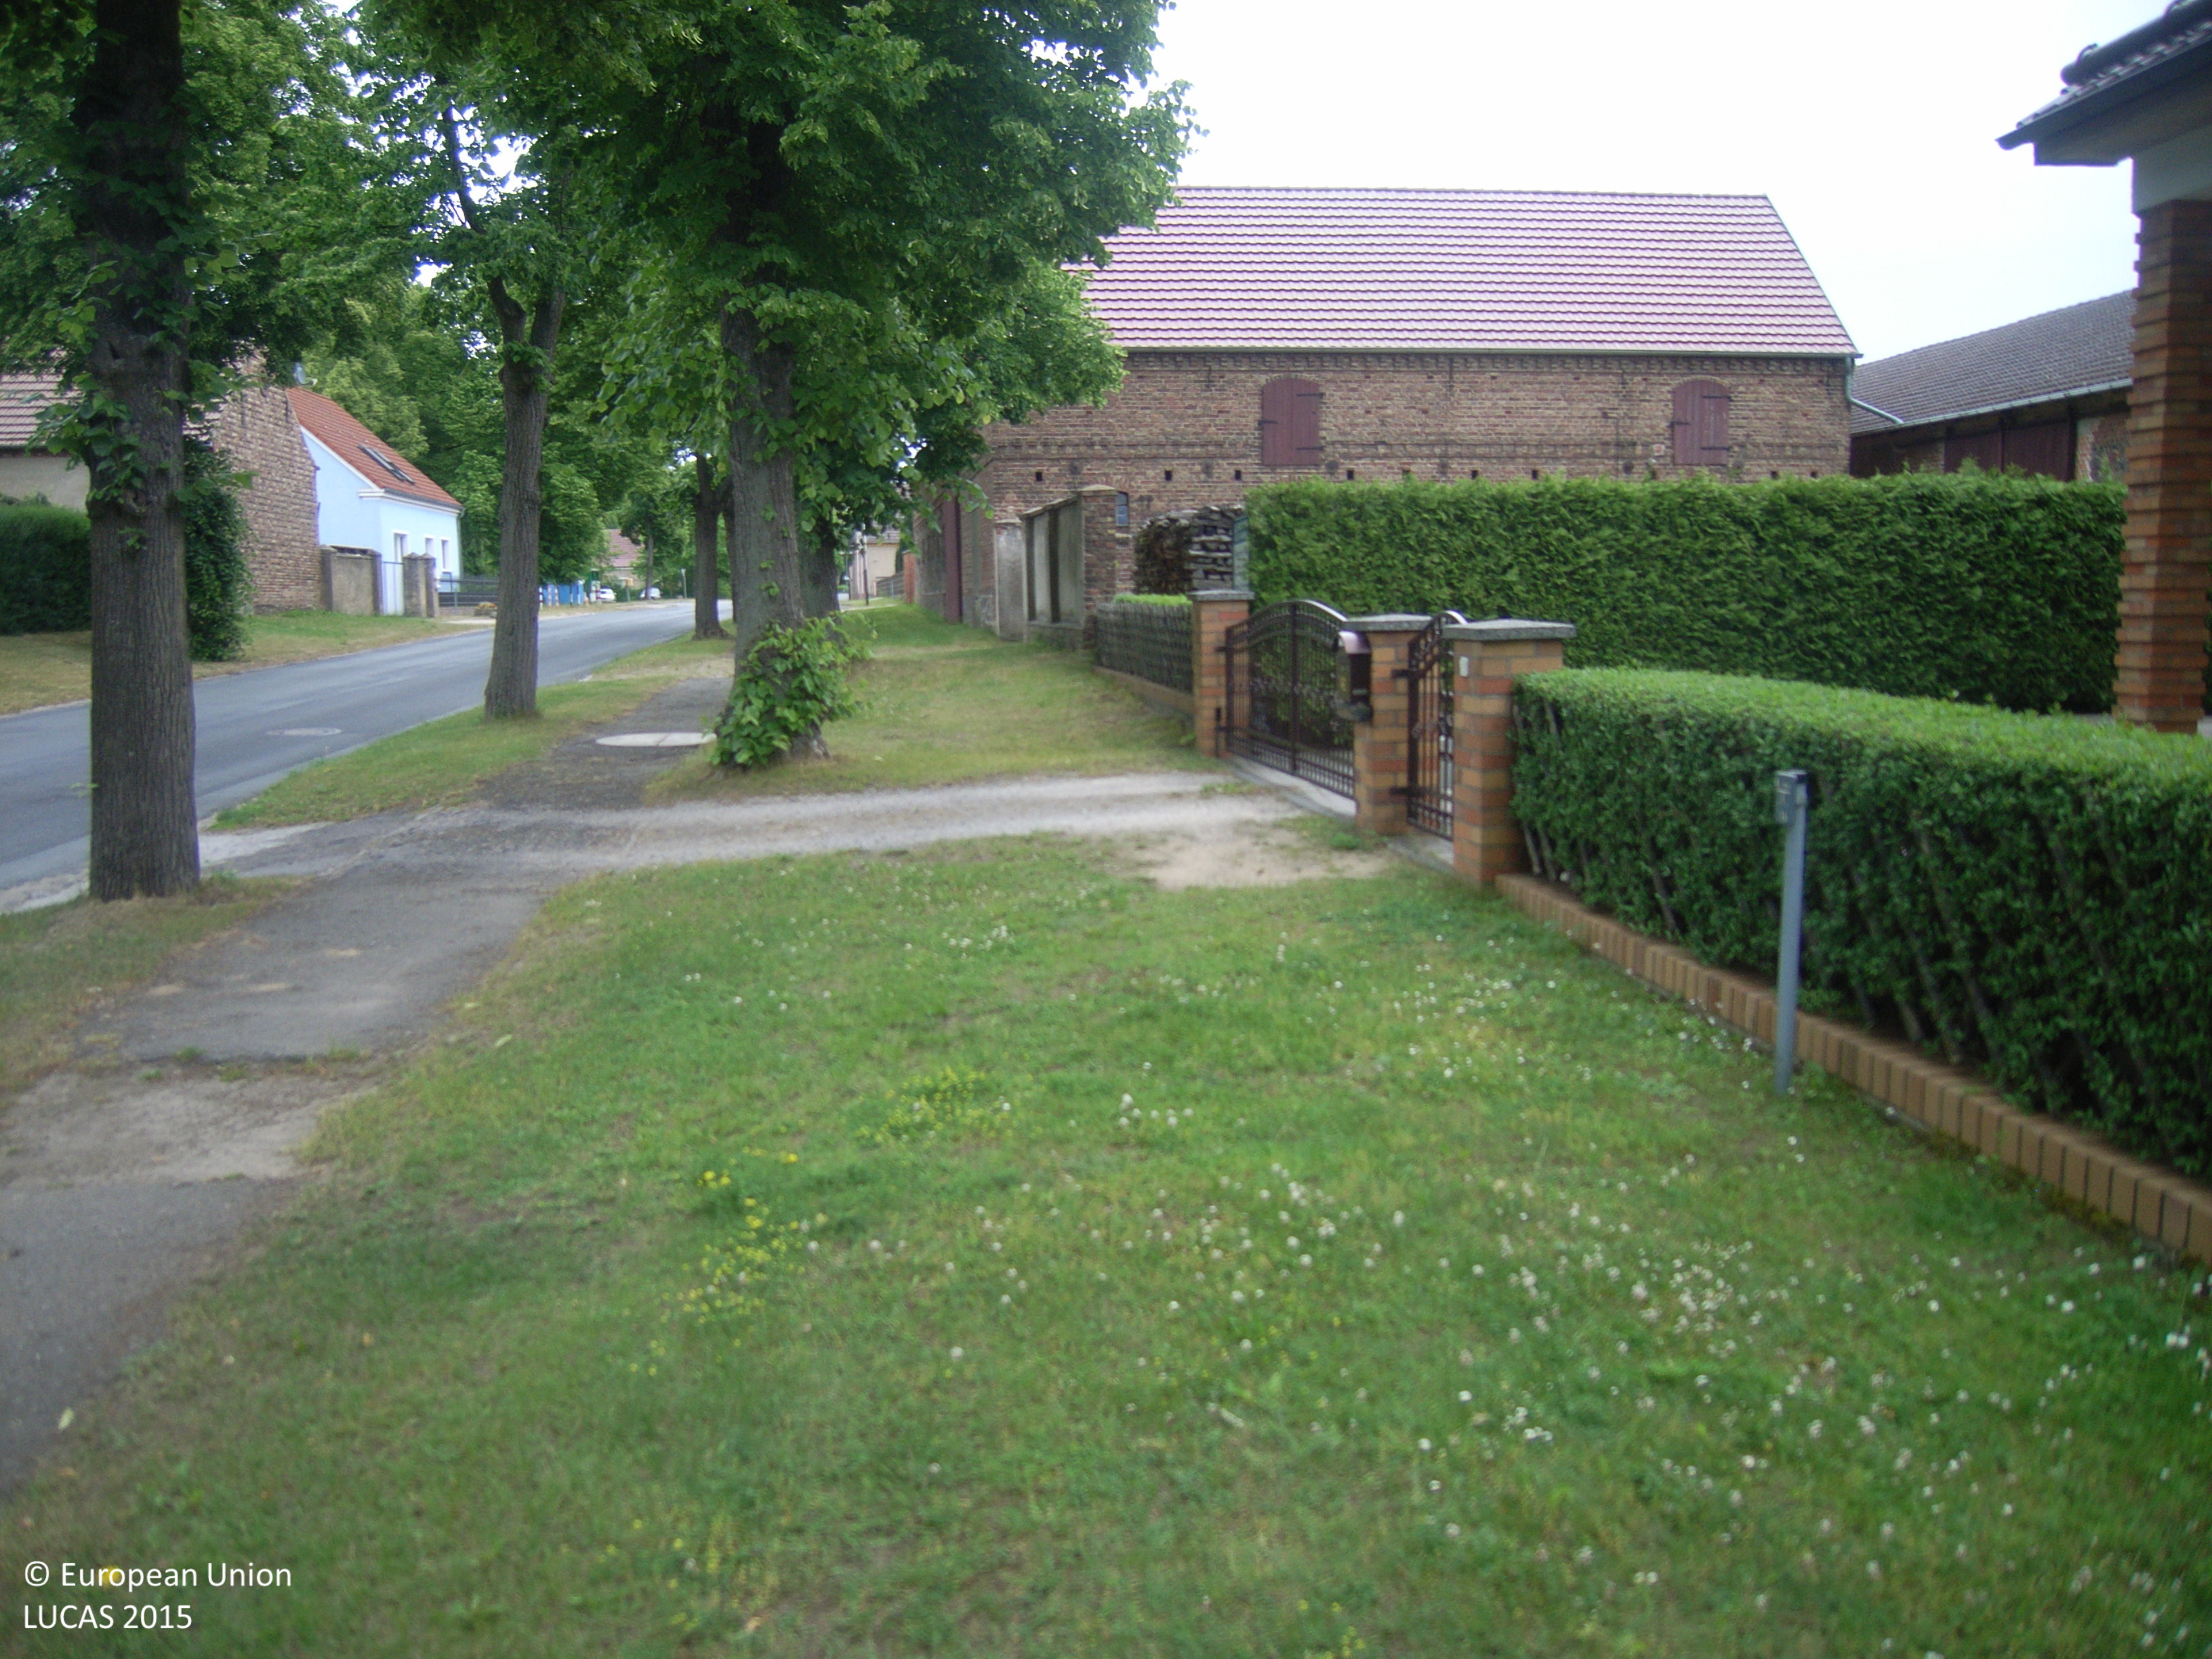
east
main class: Grassland
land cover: Grassland with sparse tree/shrub cover
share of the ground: > 75 %
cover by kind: herbaceous plants 95 %, broadleaved forest trees 5 %
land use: Road transport
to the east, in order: Grassland with sparse tree/shrub cover; Artificial constructions in urban areas
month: June
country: DE
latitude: 52.1983
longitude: 14.1122
